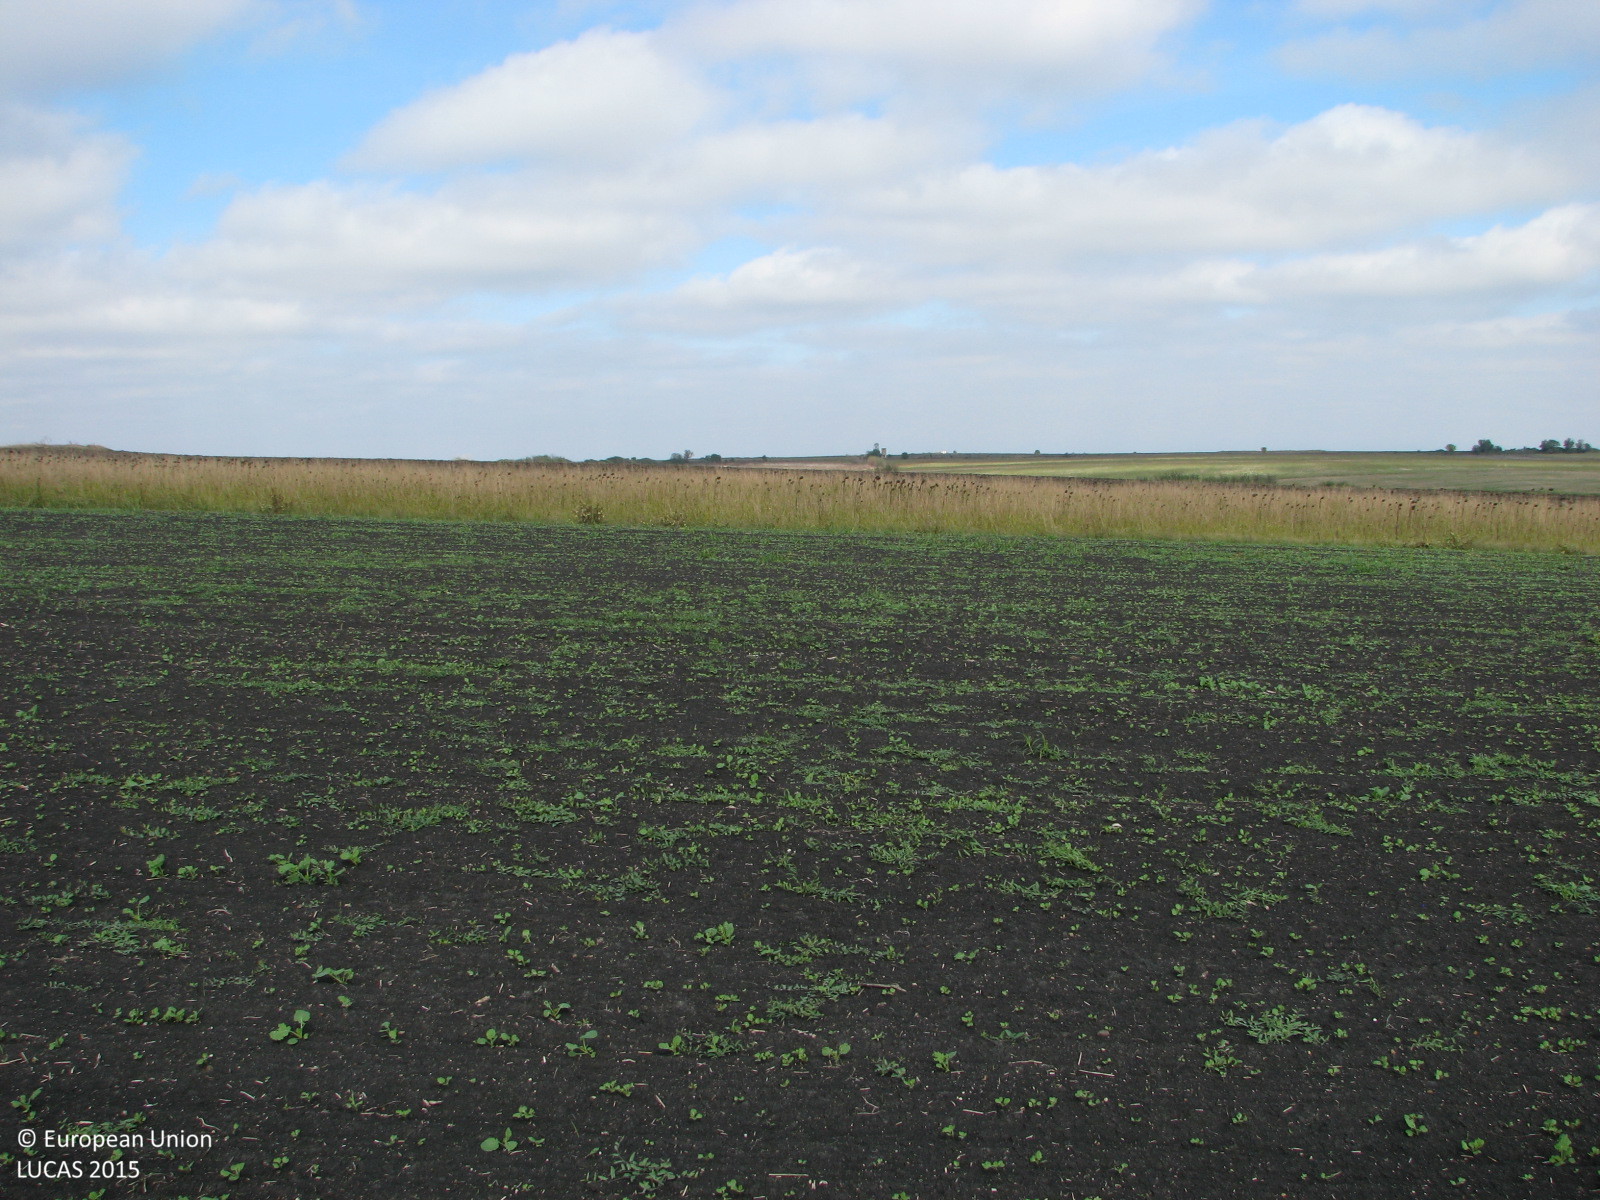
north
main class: Grassland
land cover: Spontaneously vegetated surfaces
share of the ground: 25 - 50 %
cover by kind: consolidated bare surface 70 %, herbaceous plants 30 %
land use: Agriculture (excluding fallow land and kitchen gardens)
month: October
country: BG
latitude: 42.3794
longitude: 26.4740
